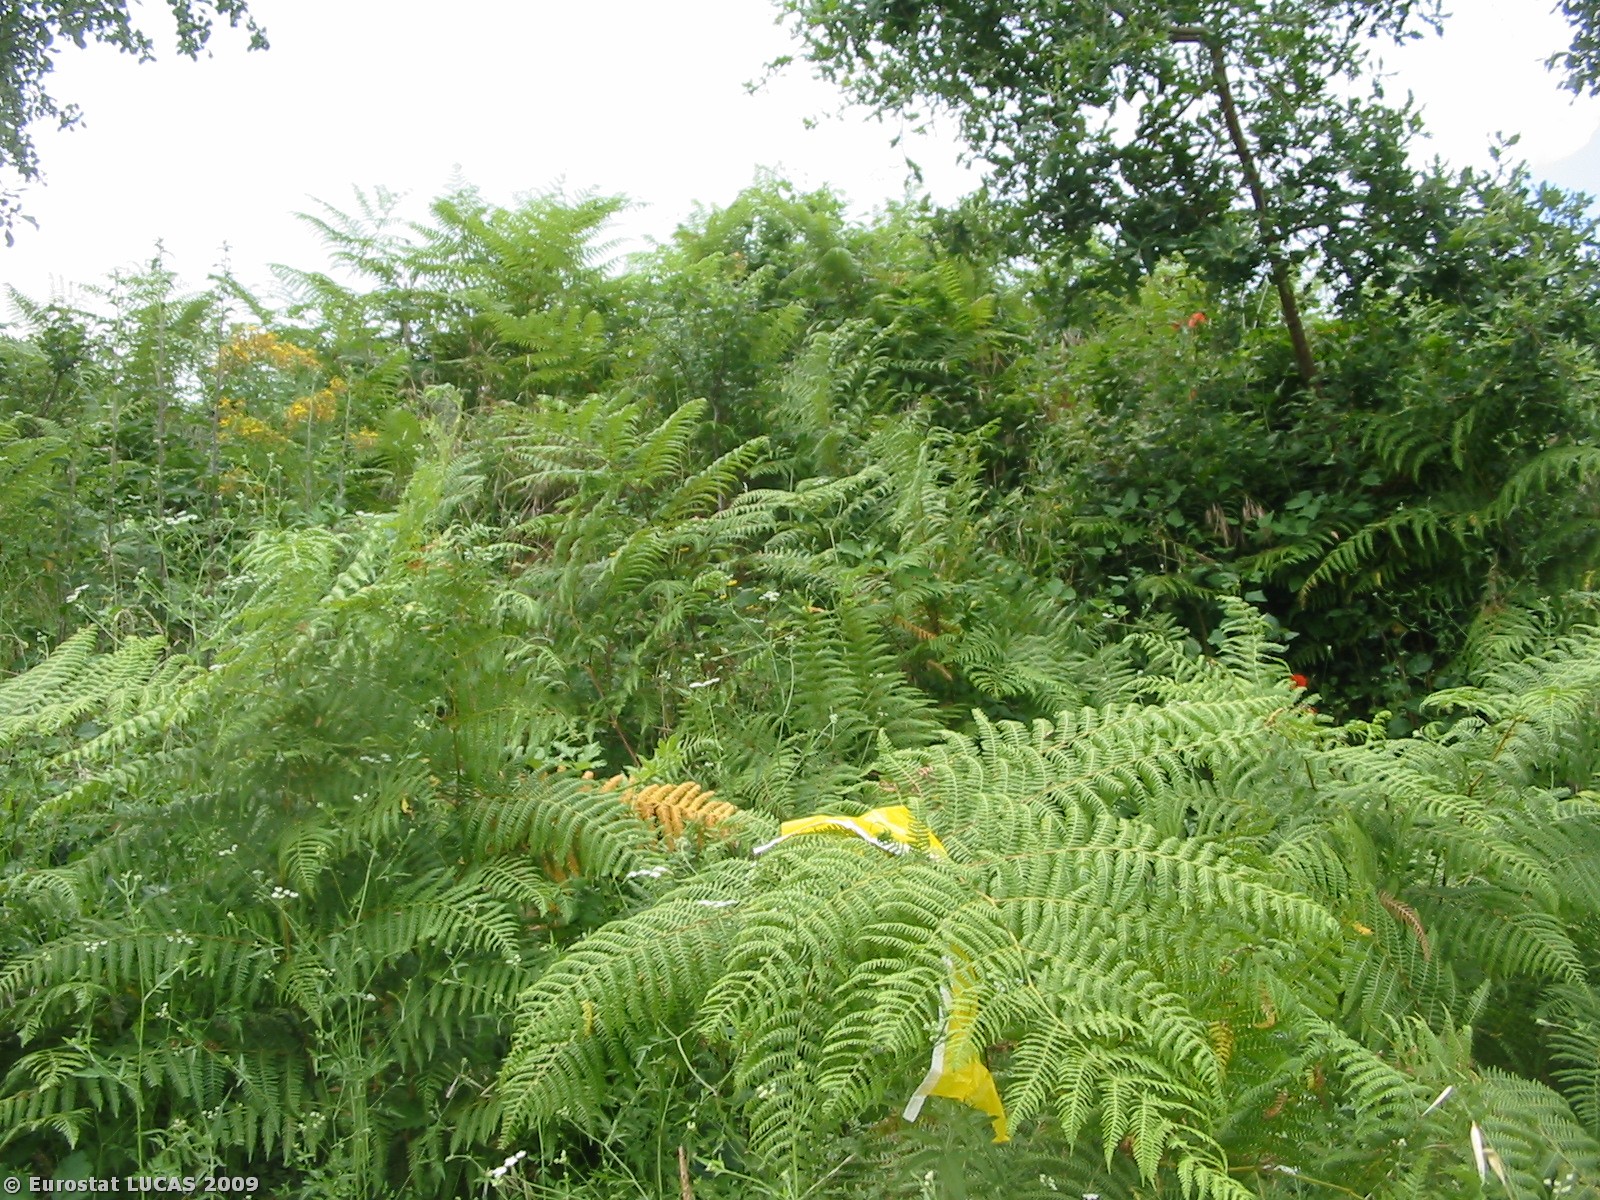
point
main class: Shrubland
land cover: Shrubland with sparse tree cover
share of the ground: > 75 %
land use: Unused
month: June
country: IT
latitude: 43.1462
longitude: 11.6550
